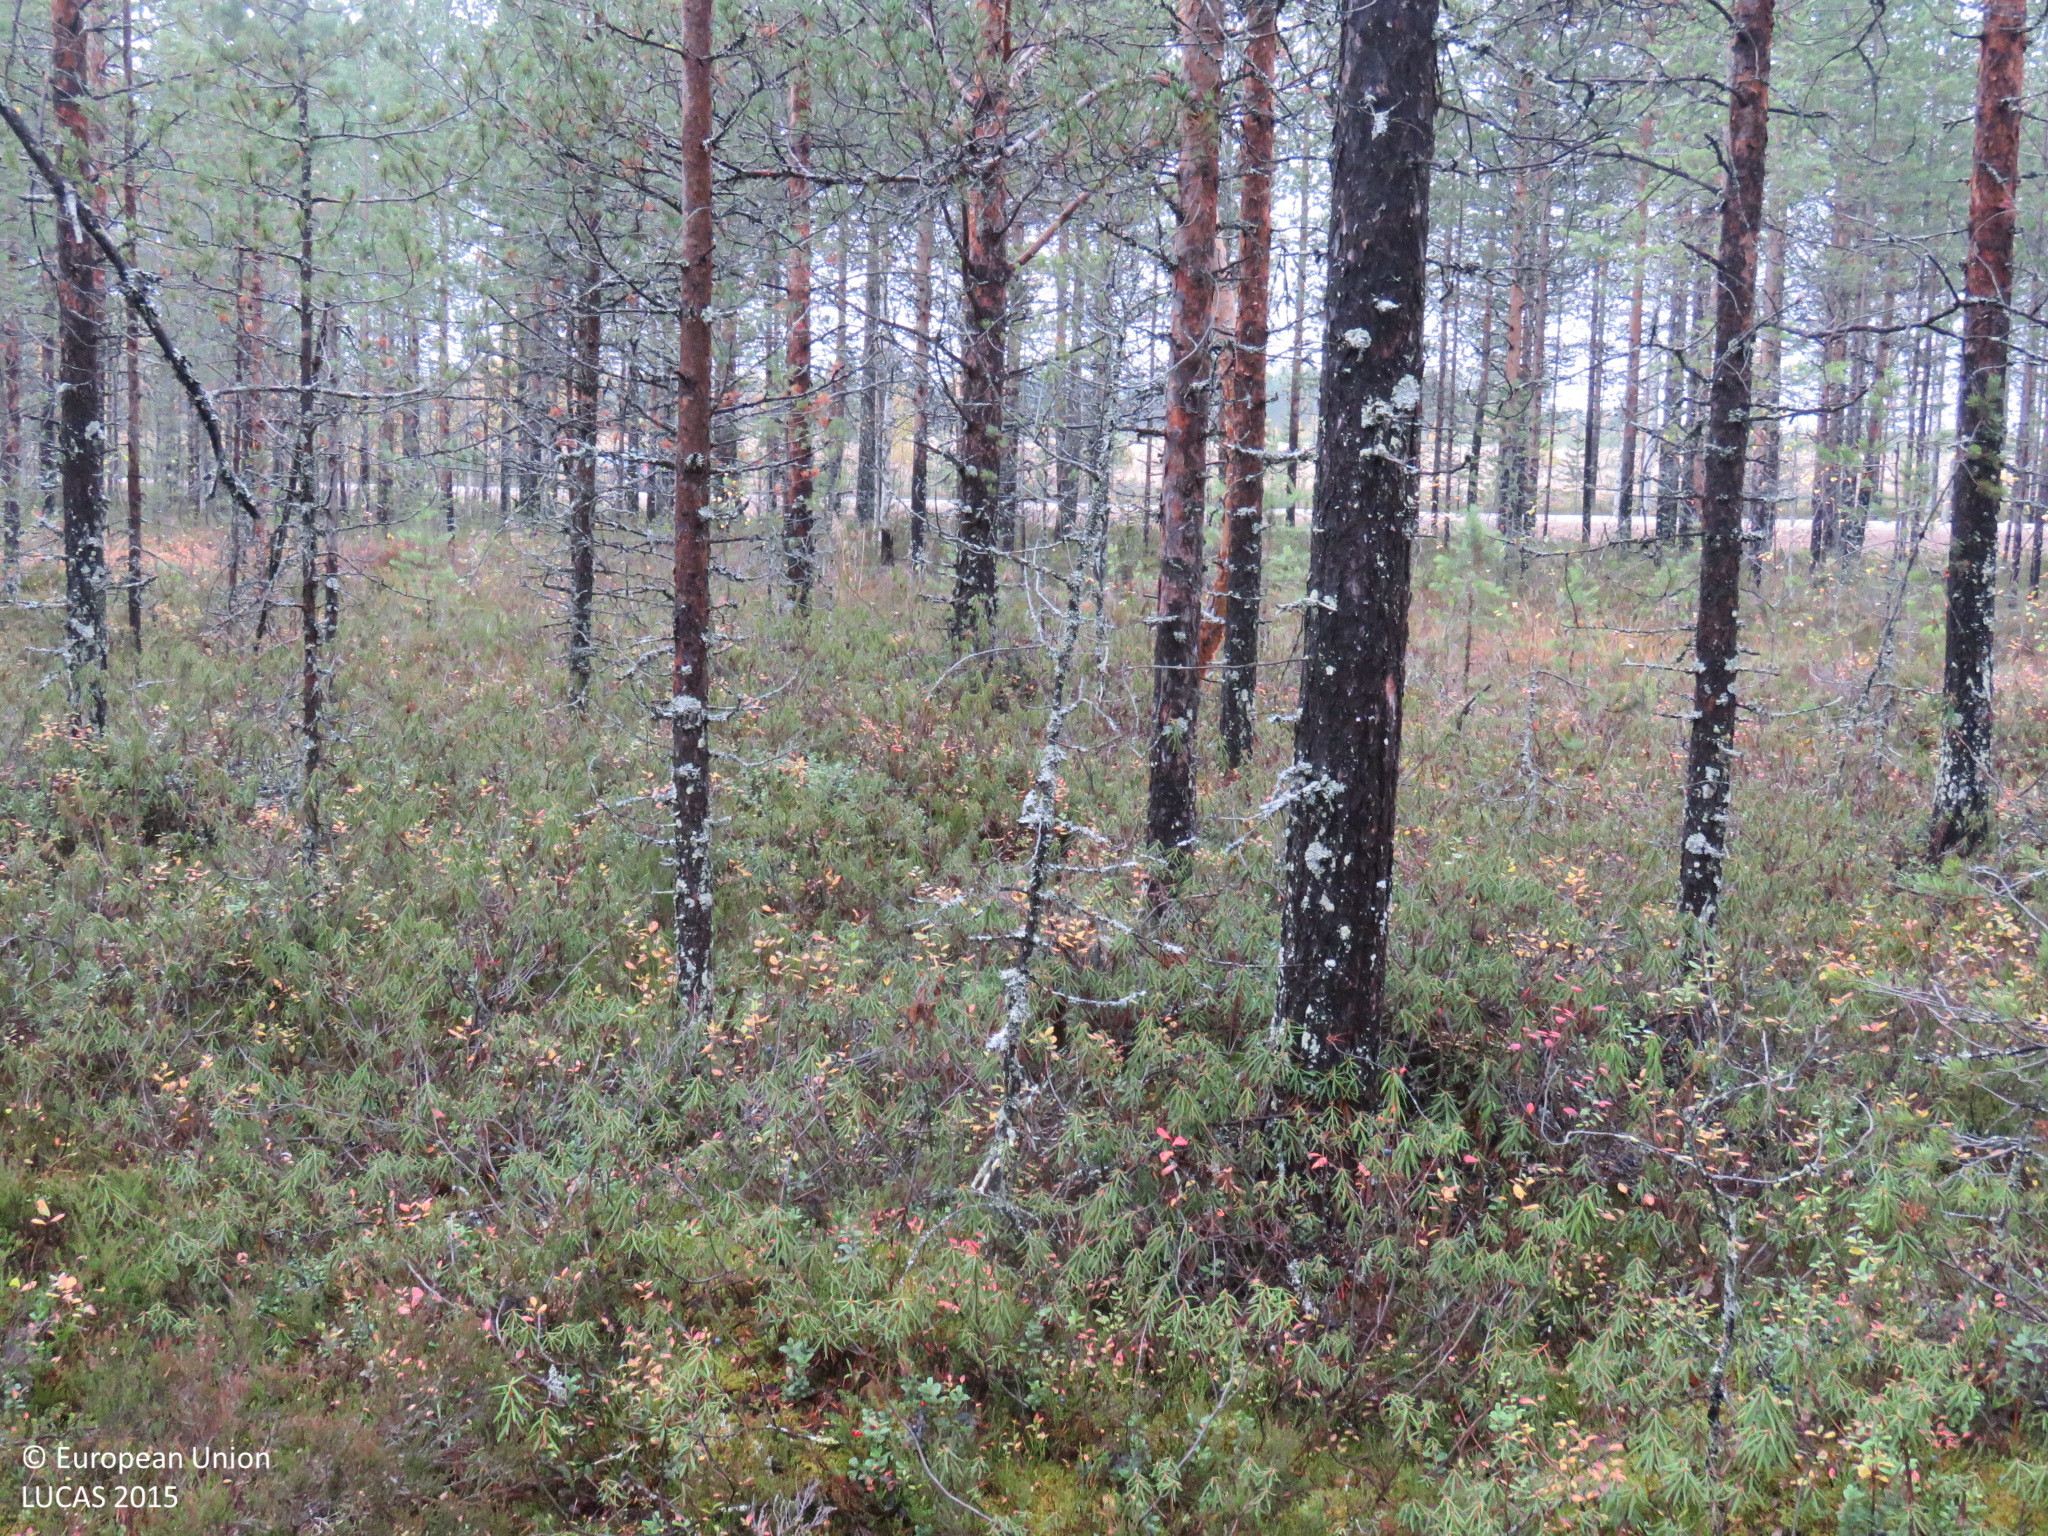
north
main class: Woodland
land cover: Pine dominated coniferous woodland
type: boreal forest
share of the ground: 50 - 75 %
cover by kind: coniferous forest trees 70 %, shrubs 25 %, lichens and mosses 5 %
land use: Forestry
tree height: > 5 m
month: September
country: FI
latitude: 65.2664
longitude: 27.0632
